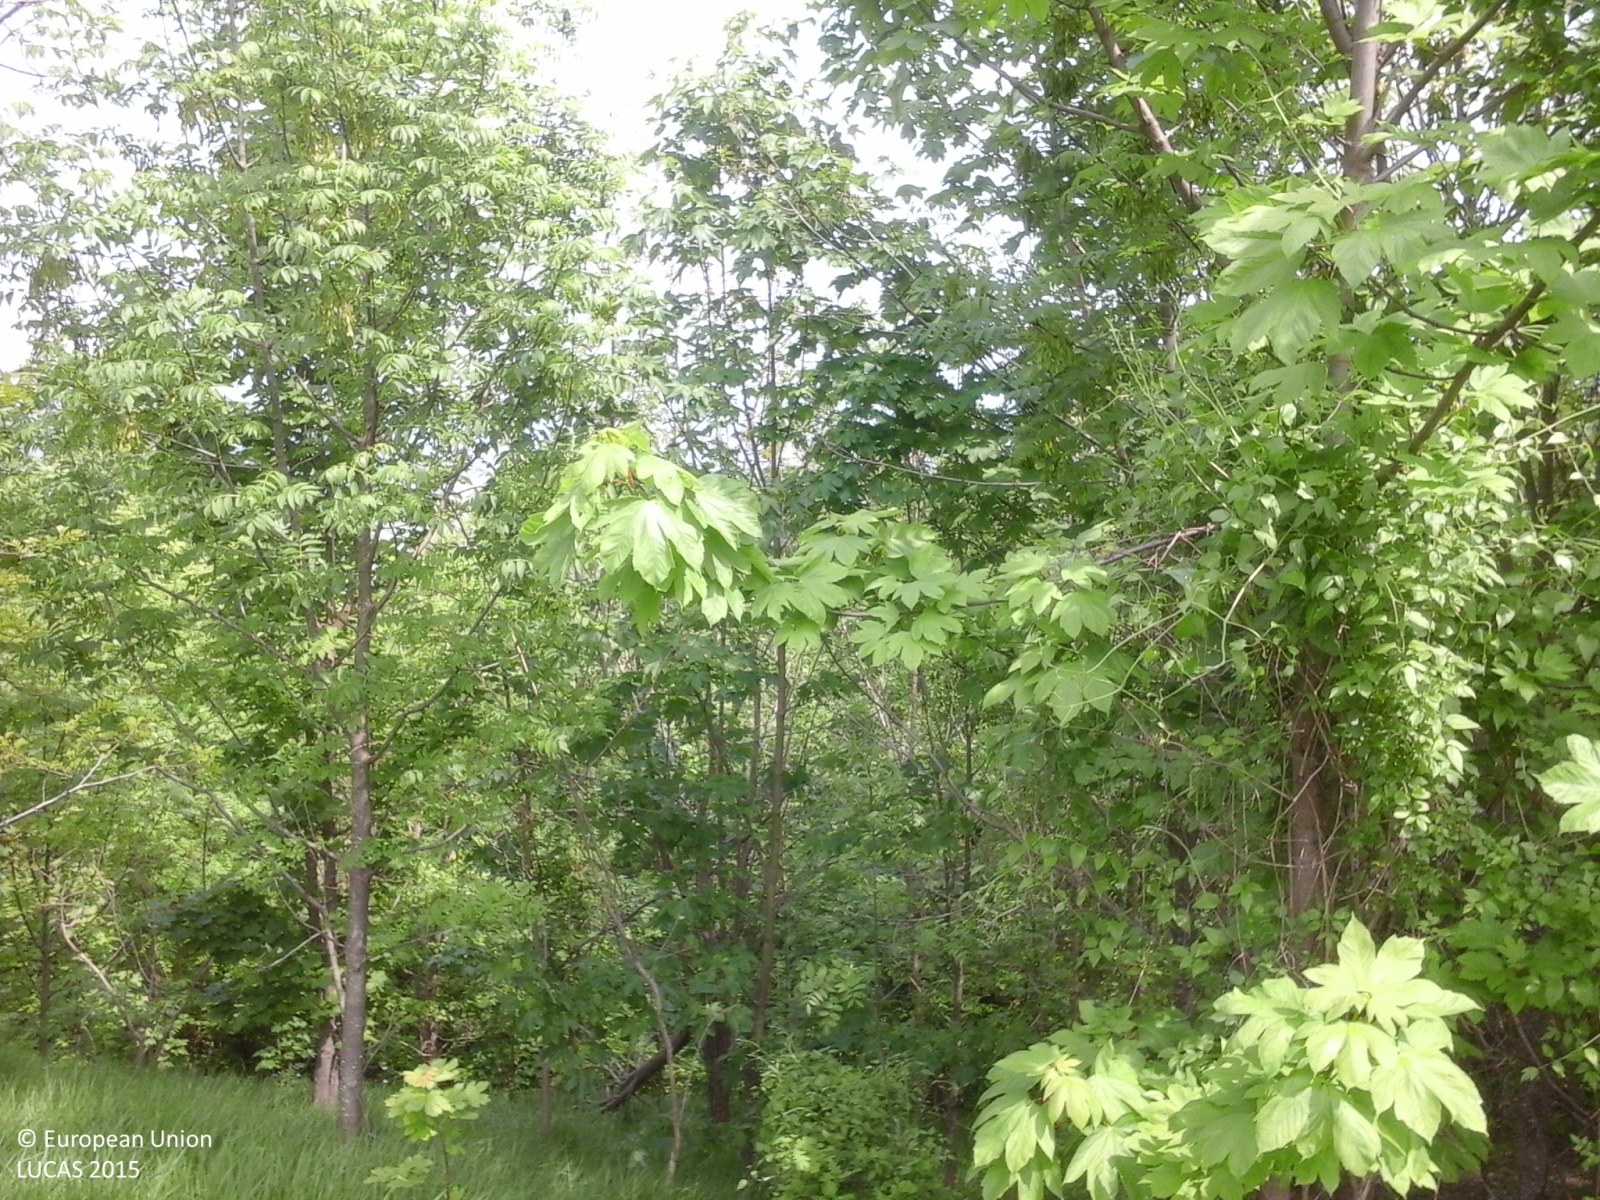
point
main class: Woodland
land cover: Broadleaved woodland
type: mesophytic deciduous forest
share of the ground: > 75 %
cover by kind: broadleaved forest trees 100 %
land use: Forestry
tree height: > 5 m
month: May
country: IT
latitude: 44.3289
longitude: 10.8633
